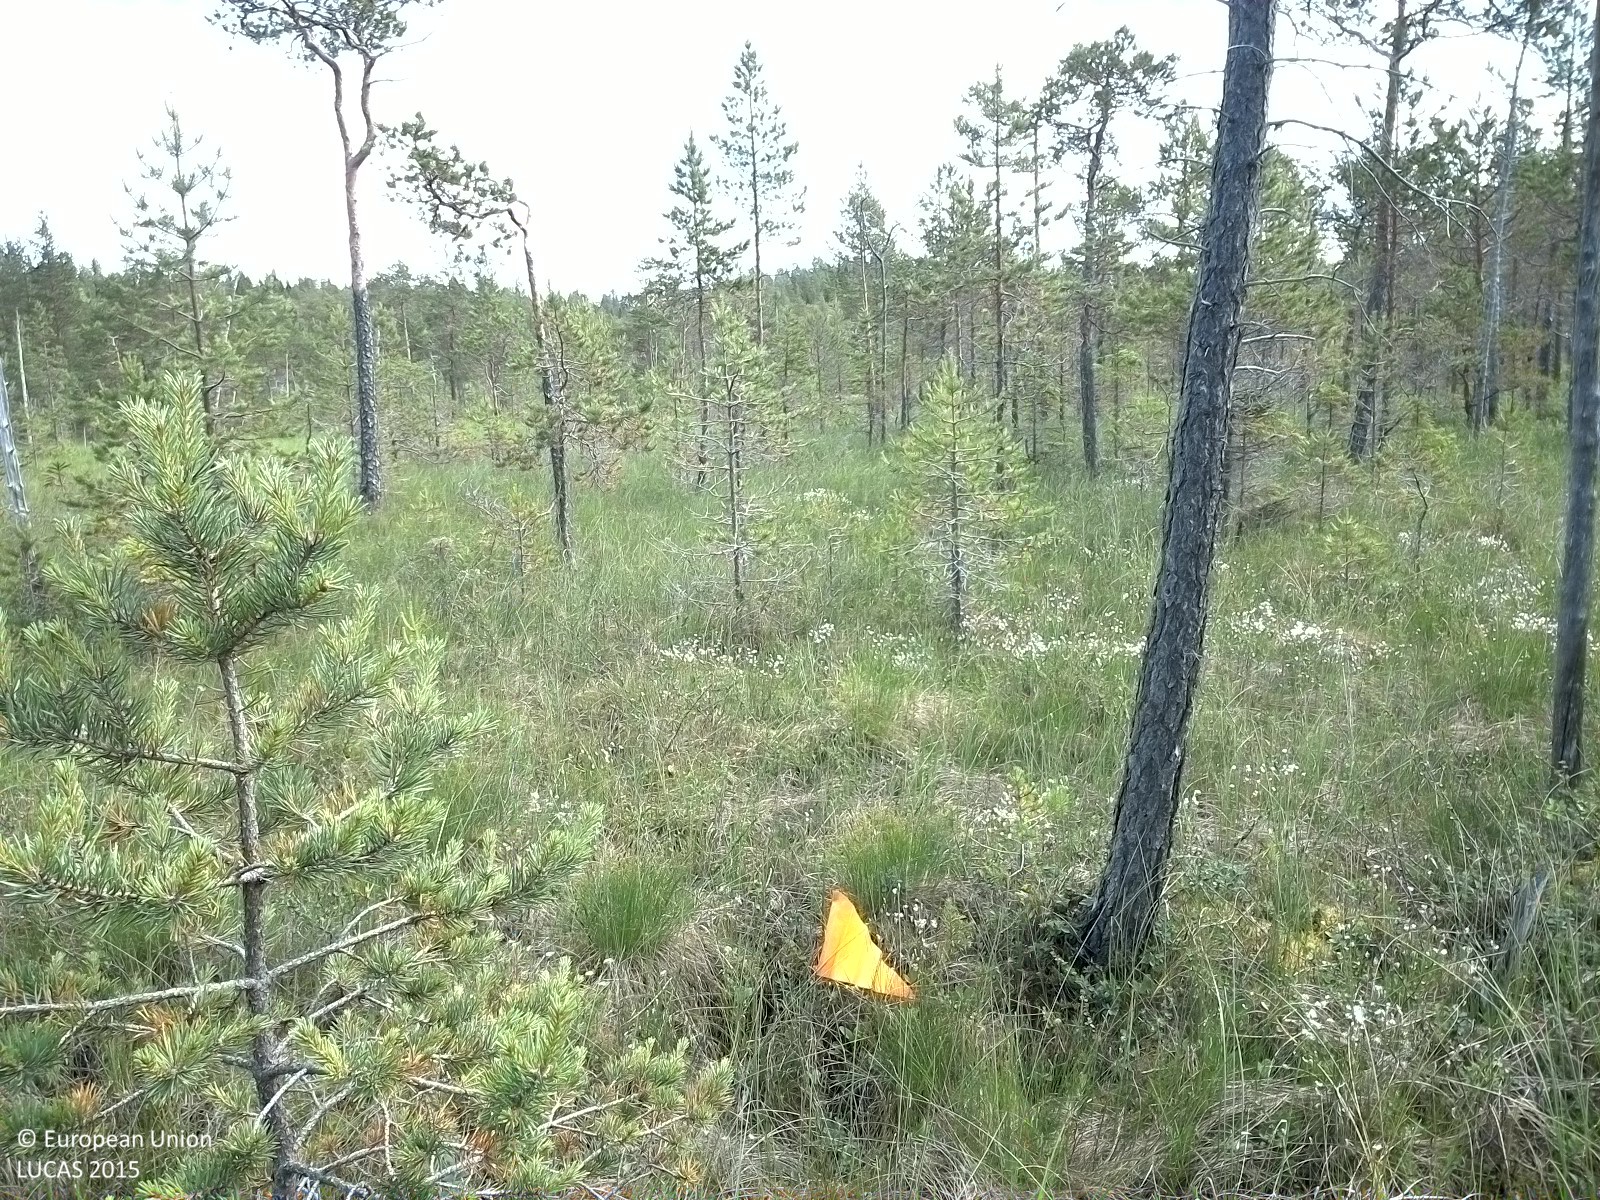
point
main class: Woodland
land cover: Pine dominated coniferous woodland
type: boreal forest
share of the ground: 10 - 25 %
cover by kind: shrubs 55 %, herbaceous plants 30 %, coniferous forest trees 10 %, lichens and mosses 5 %
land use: Semi-natural and natural areas not in use
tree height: < 5 m
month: July
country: SE
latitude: 62.6083
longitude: 17.0903
